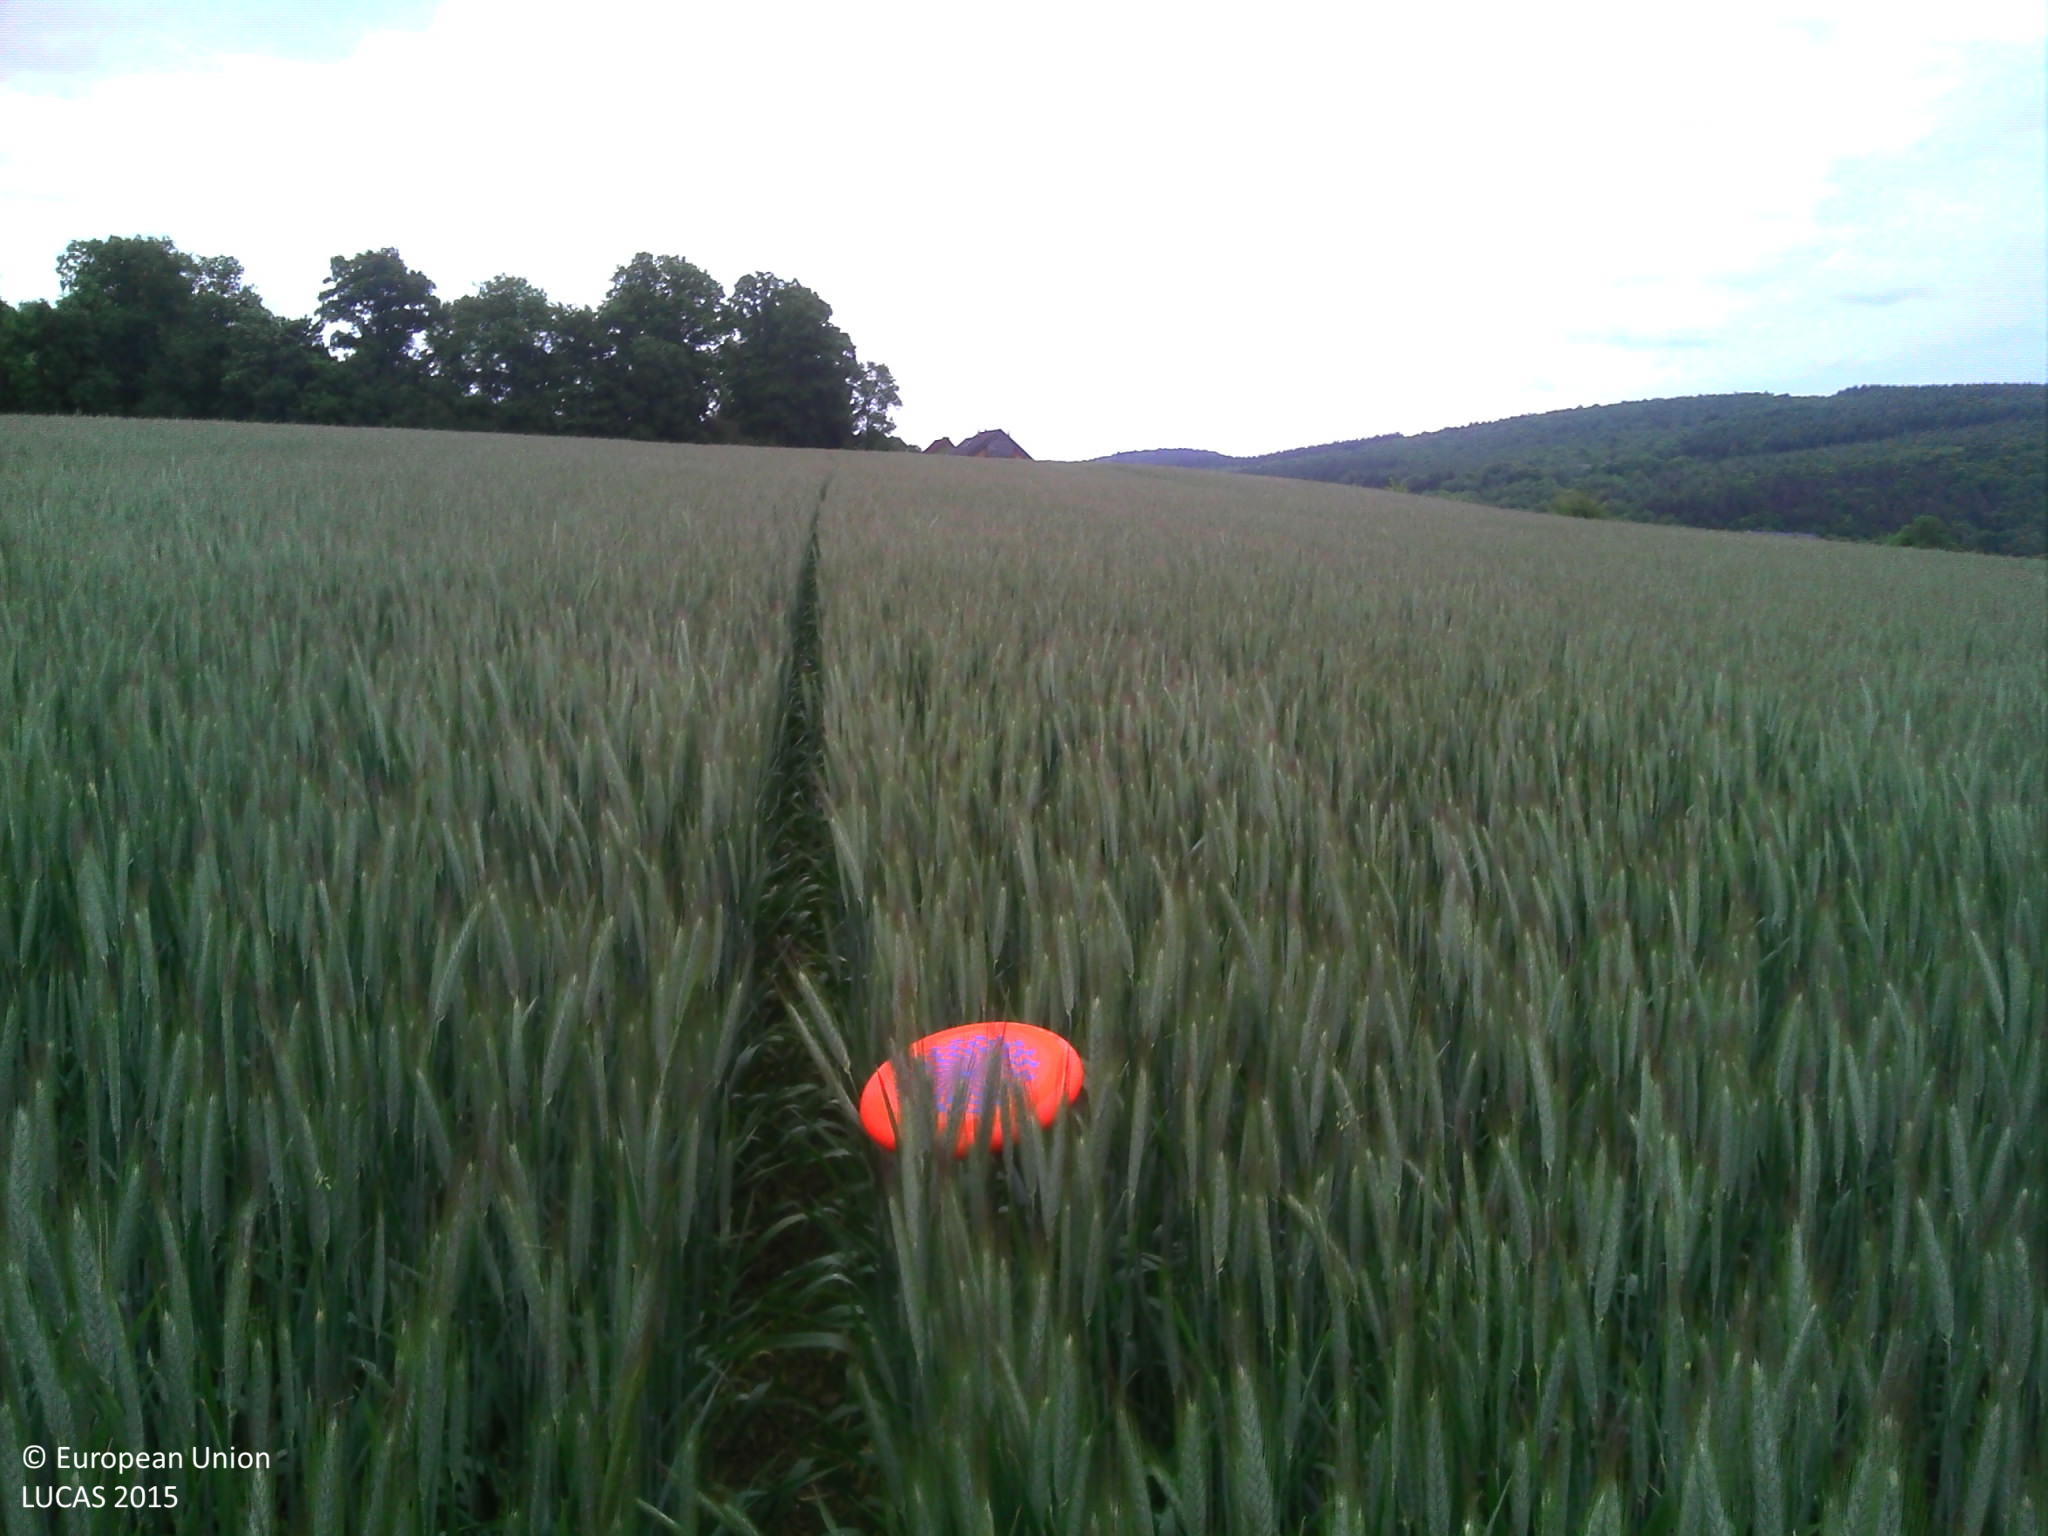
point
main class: Cropland
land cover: Triticale
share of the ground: > 75 %
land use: Agriculture (excluding fallow land and kitchen gardens)
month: May
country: BE
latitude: 50.1575
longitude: 5.2528
